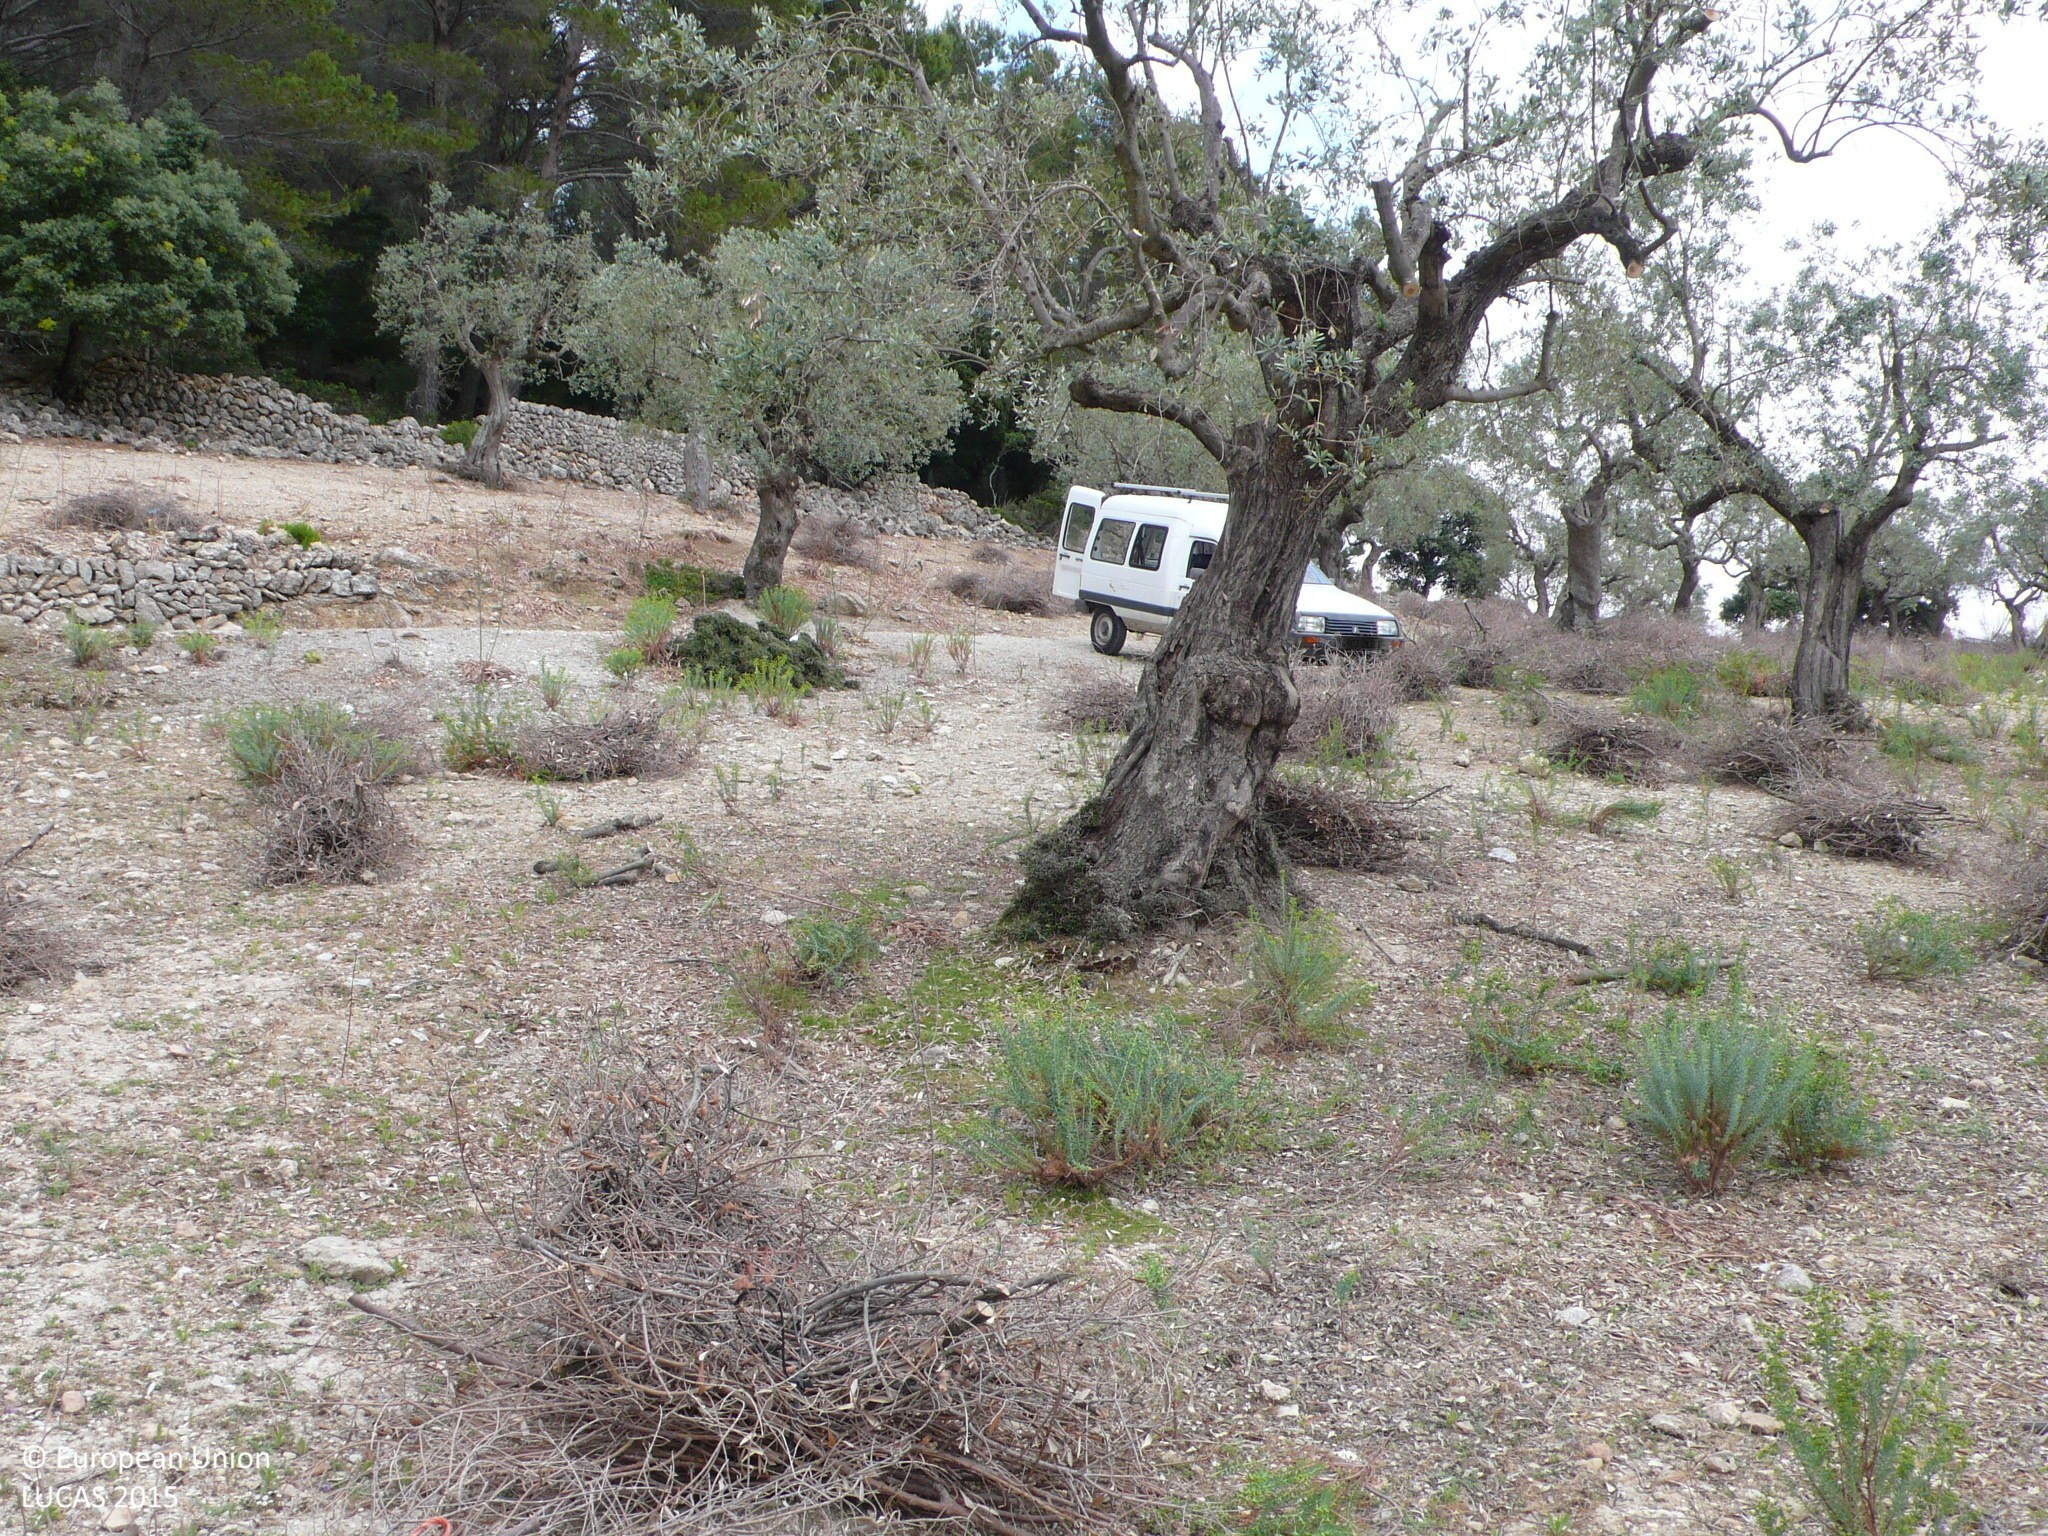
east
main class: Cropland
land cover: Olive groves
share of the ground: 25 - 50 %
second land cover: Spontaneously vegetated surfaces
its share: 10 - 25 %
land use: Agriculture (excluding fallow land and kitchen gardens)
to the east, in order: Olive groves; Spontaneously vegetated surfaces; Tracks; Olive groves; Dry stone walls; Pine dominated mixed woodland; Broadleaved woodland; Pine dominated mixed woodland; Dry stone walls; Pine dominated mixed woodland
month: June
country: ES
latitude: 39.7288
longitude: 2.7840
